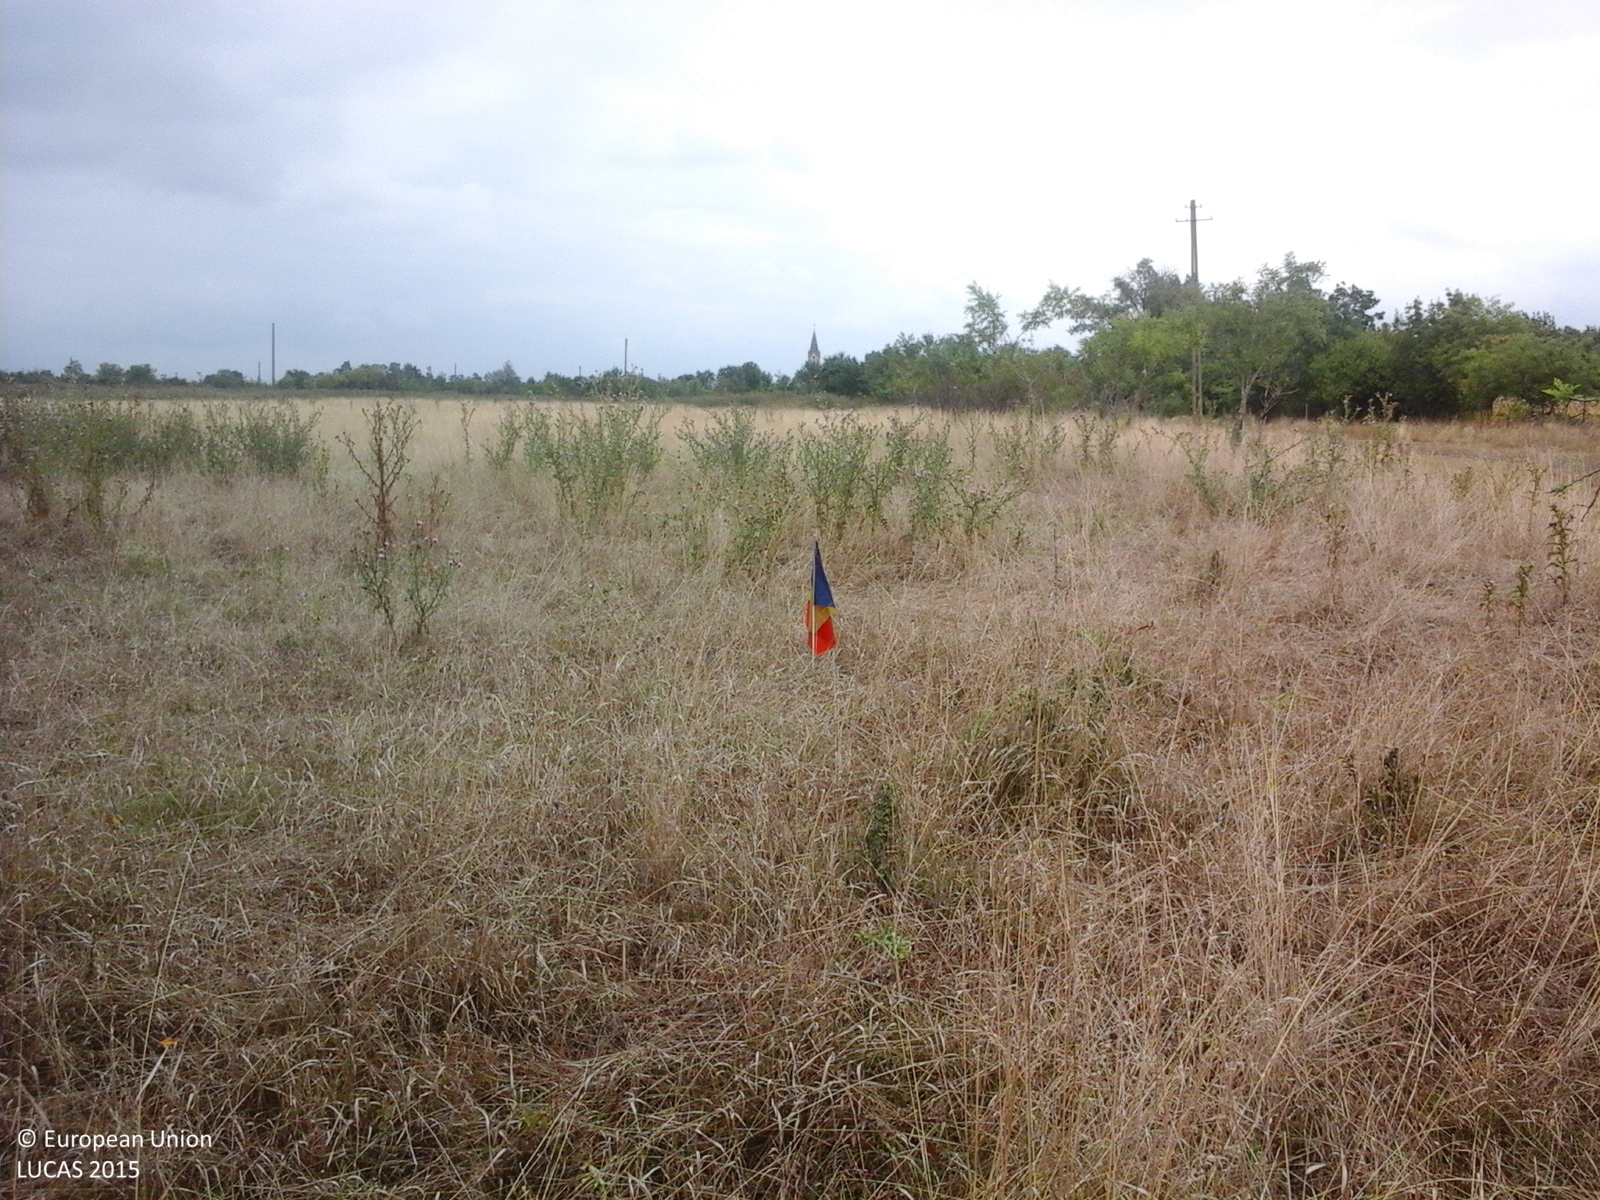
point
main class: Grassland
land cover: Spontaneously vegetated surfaces
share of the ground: > 75 %
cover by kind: herbaceous plants 100 %
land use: Semi-natural and natural areas not in use
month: August
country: RO
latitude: 46.0960
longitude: 20.4104
